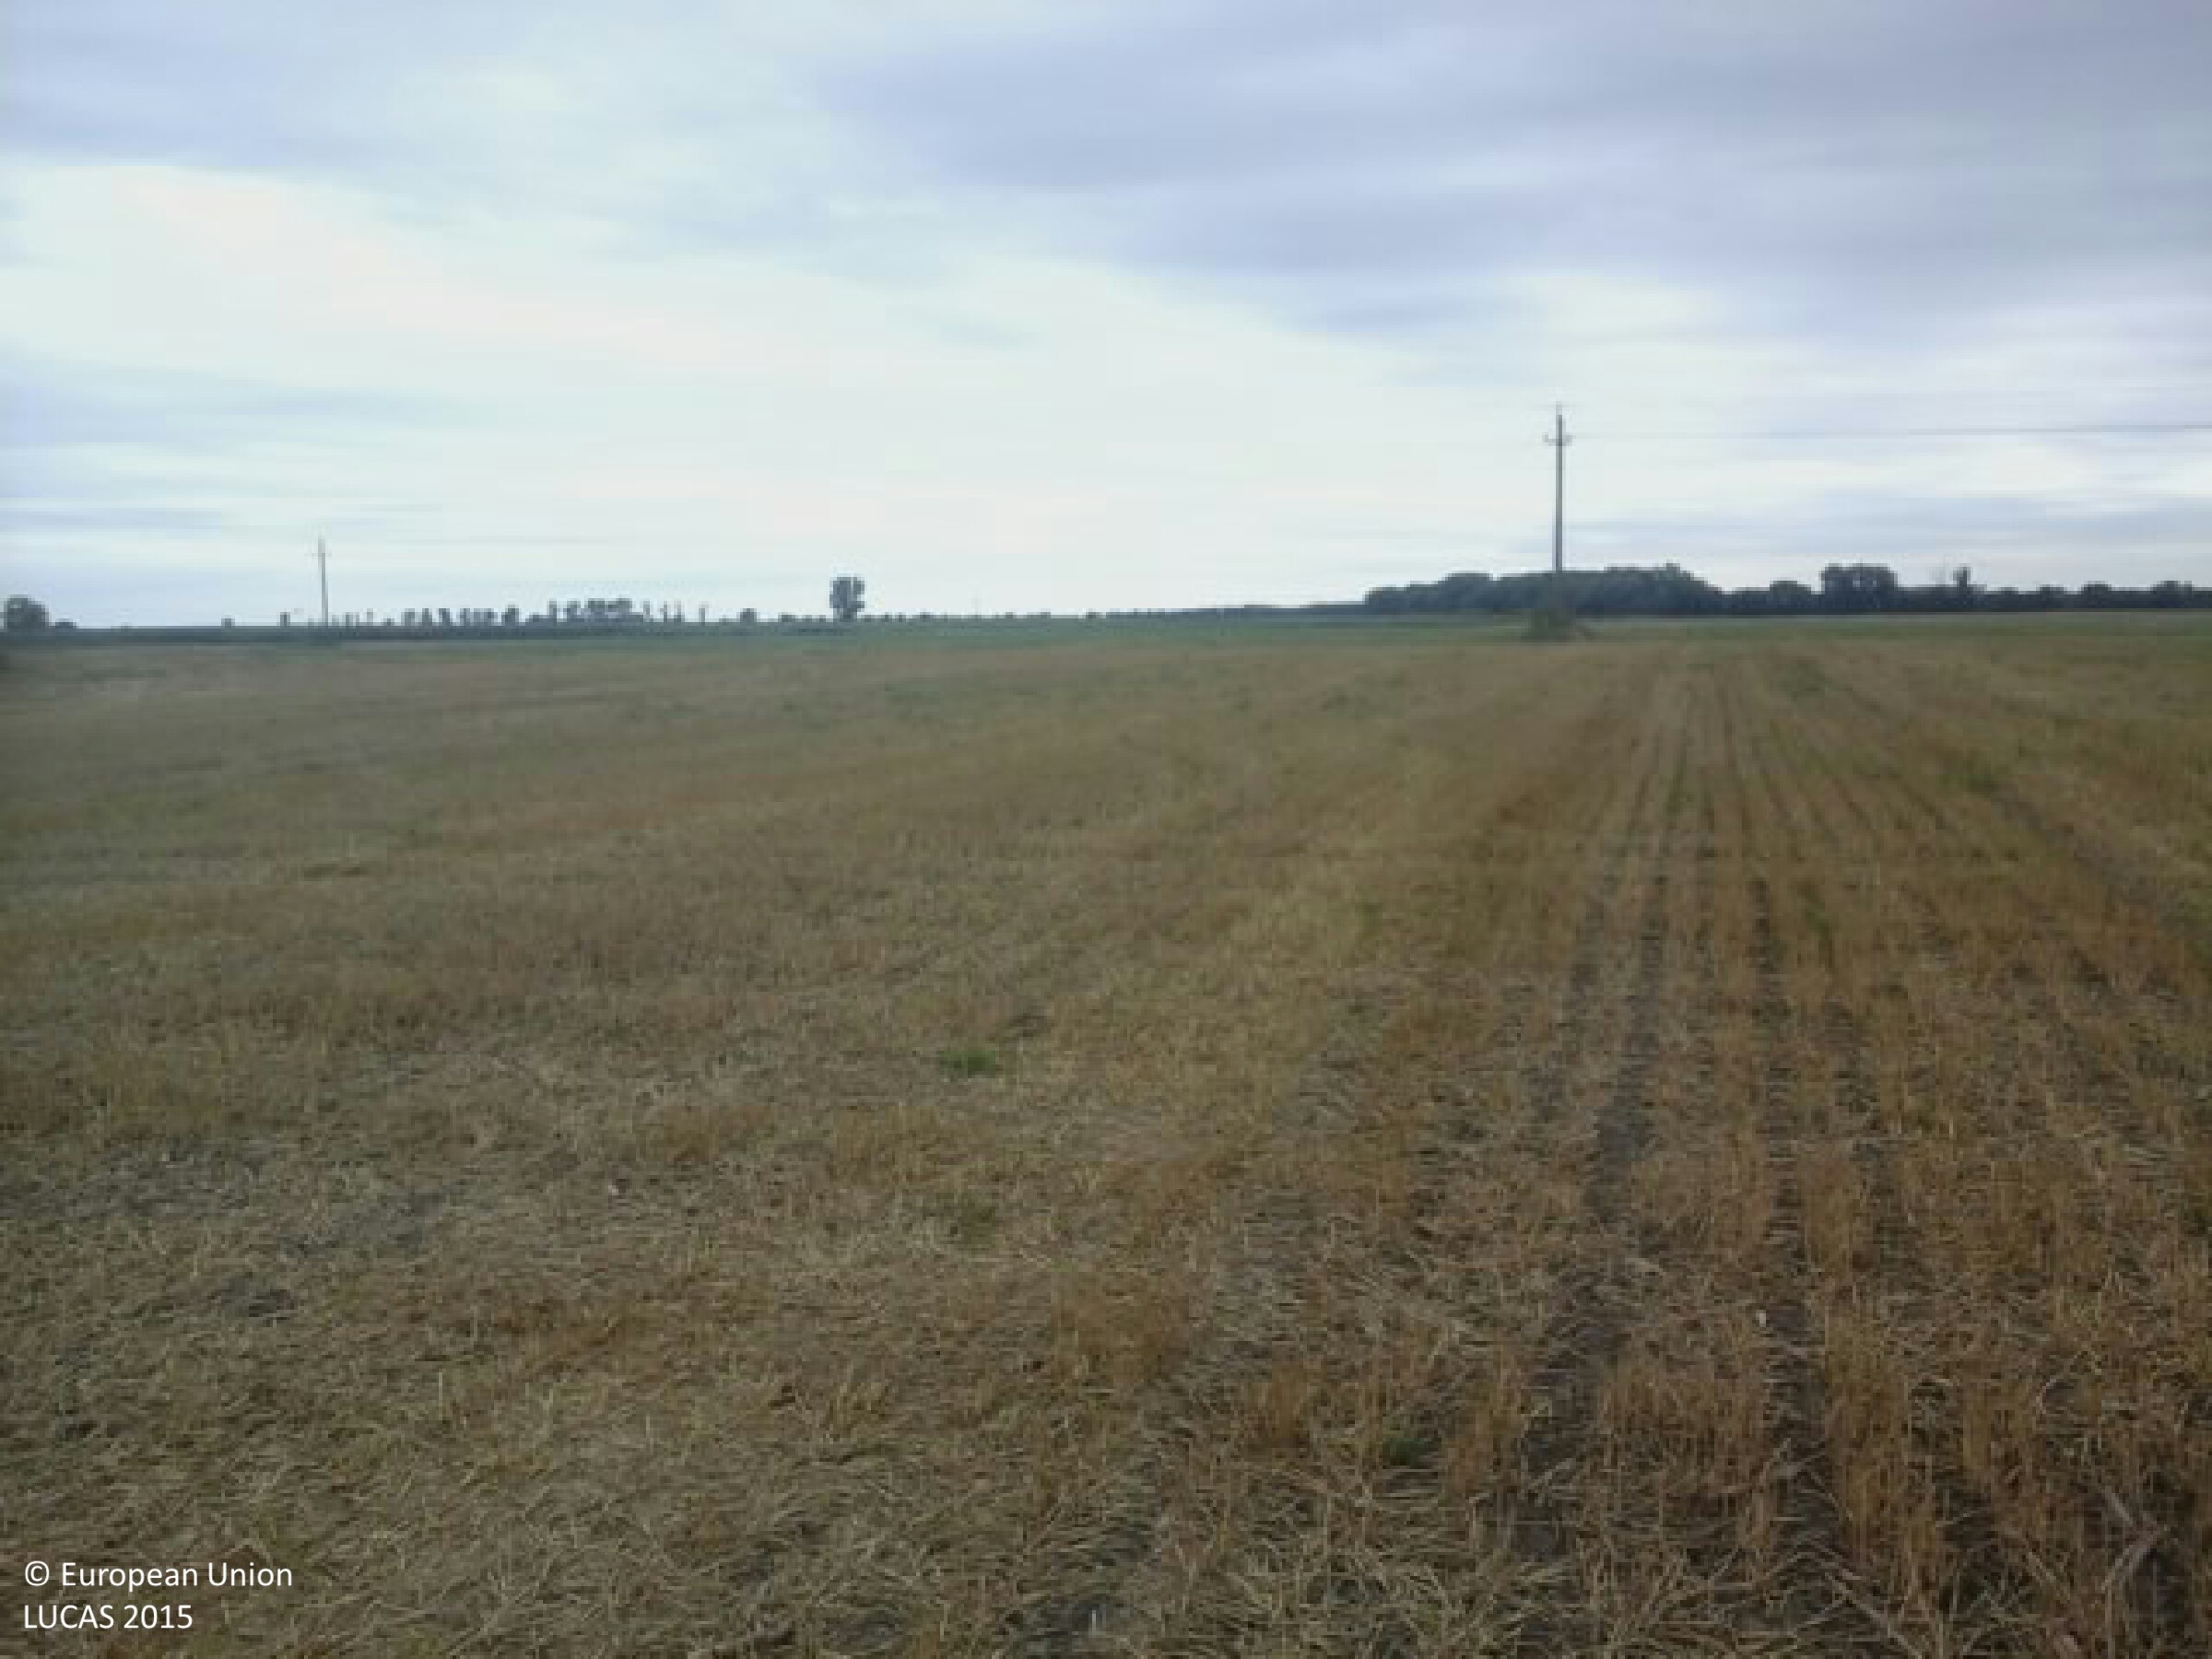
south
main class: Cropland
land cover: Common wheat
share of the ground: 25 - 50 %
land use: Agriculture (excluding fallow land and kitchen gardens)
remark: Harvested field
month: August
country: HU
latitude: 46.4973
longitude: 18.9910
